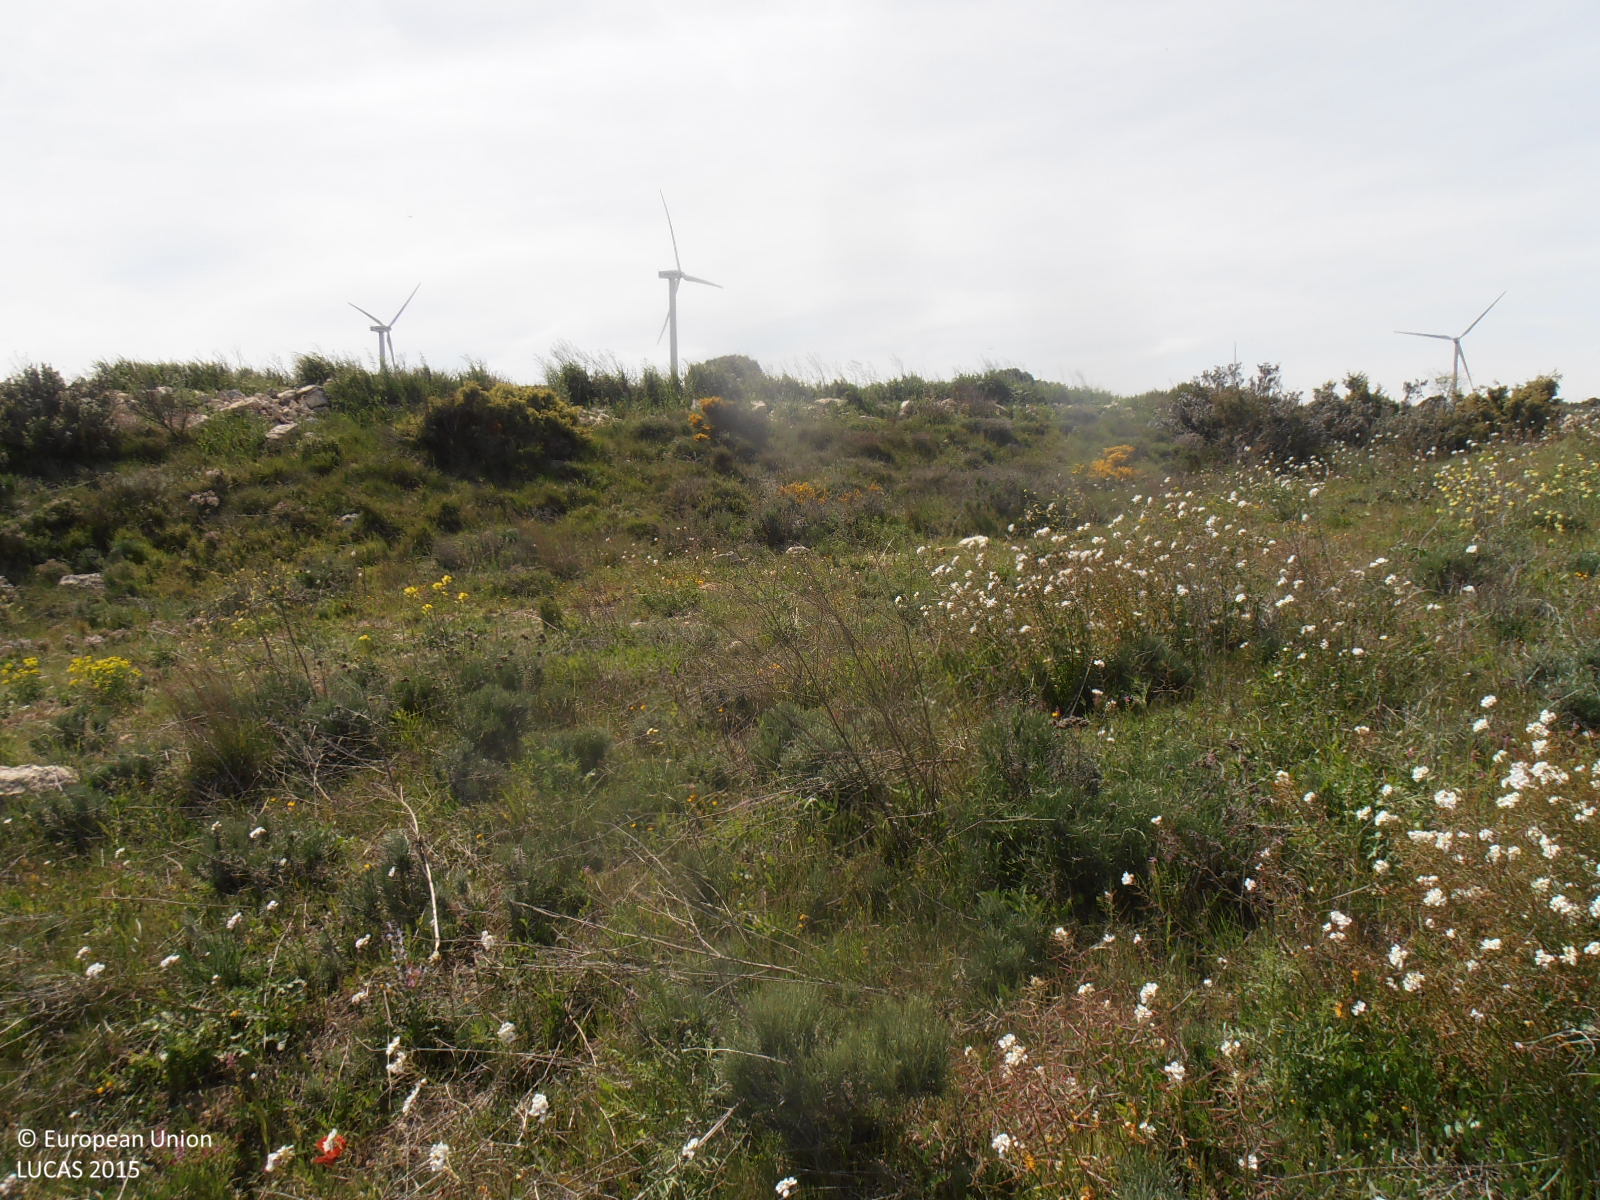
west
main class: Grassland
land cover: Grassland without tree/shrub cover
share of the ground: > 75 %
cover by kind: herbaceous plants 95 %, shrubs 5 %
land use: Abandoned areas
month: April
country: ES
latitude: 41.3655
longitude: -0.9583
